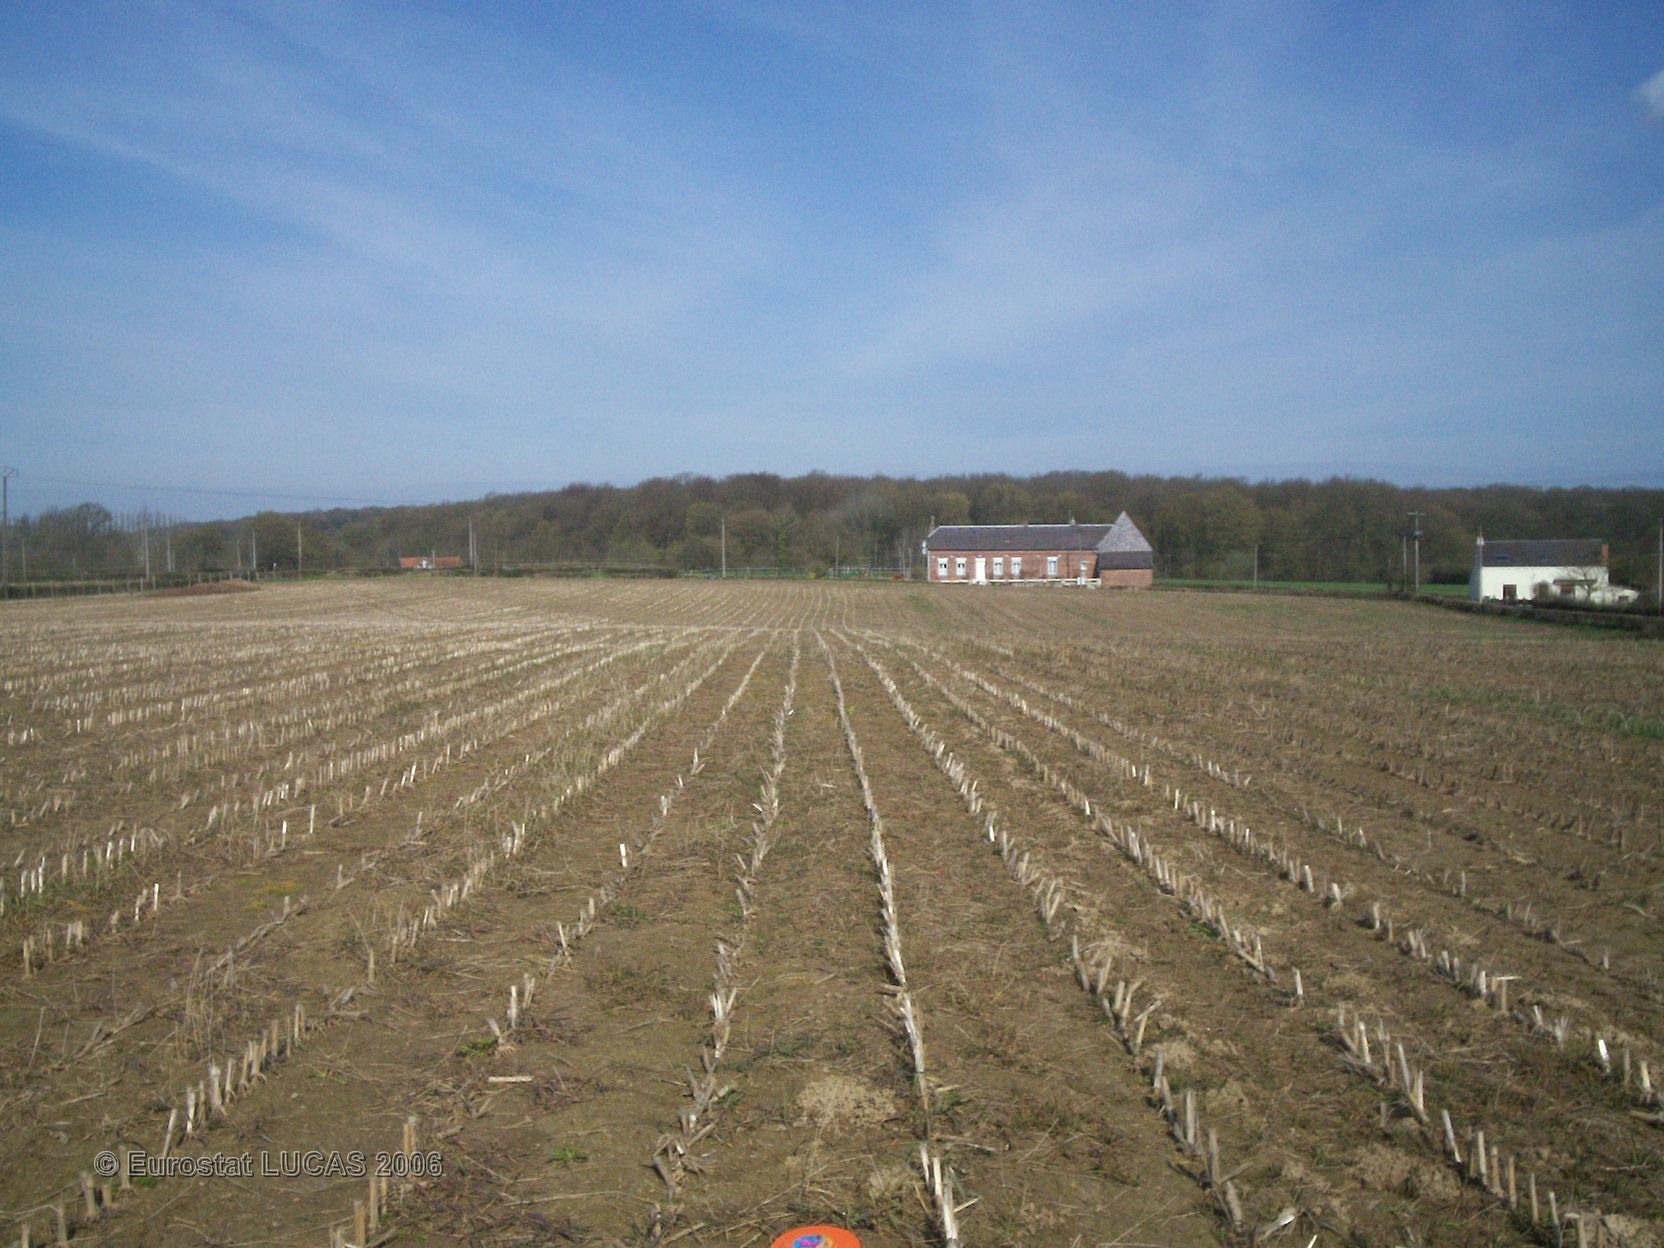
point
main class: Cropland
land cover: Maize
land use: Agriculture (excluding fallow land and kitchen gardens)
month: April
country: FR
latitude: 50.1369
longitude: 3.7113
